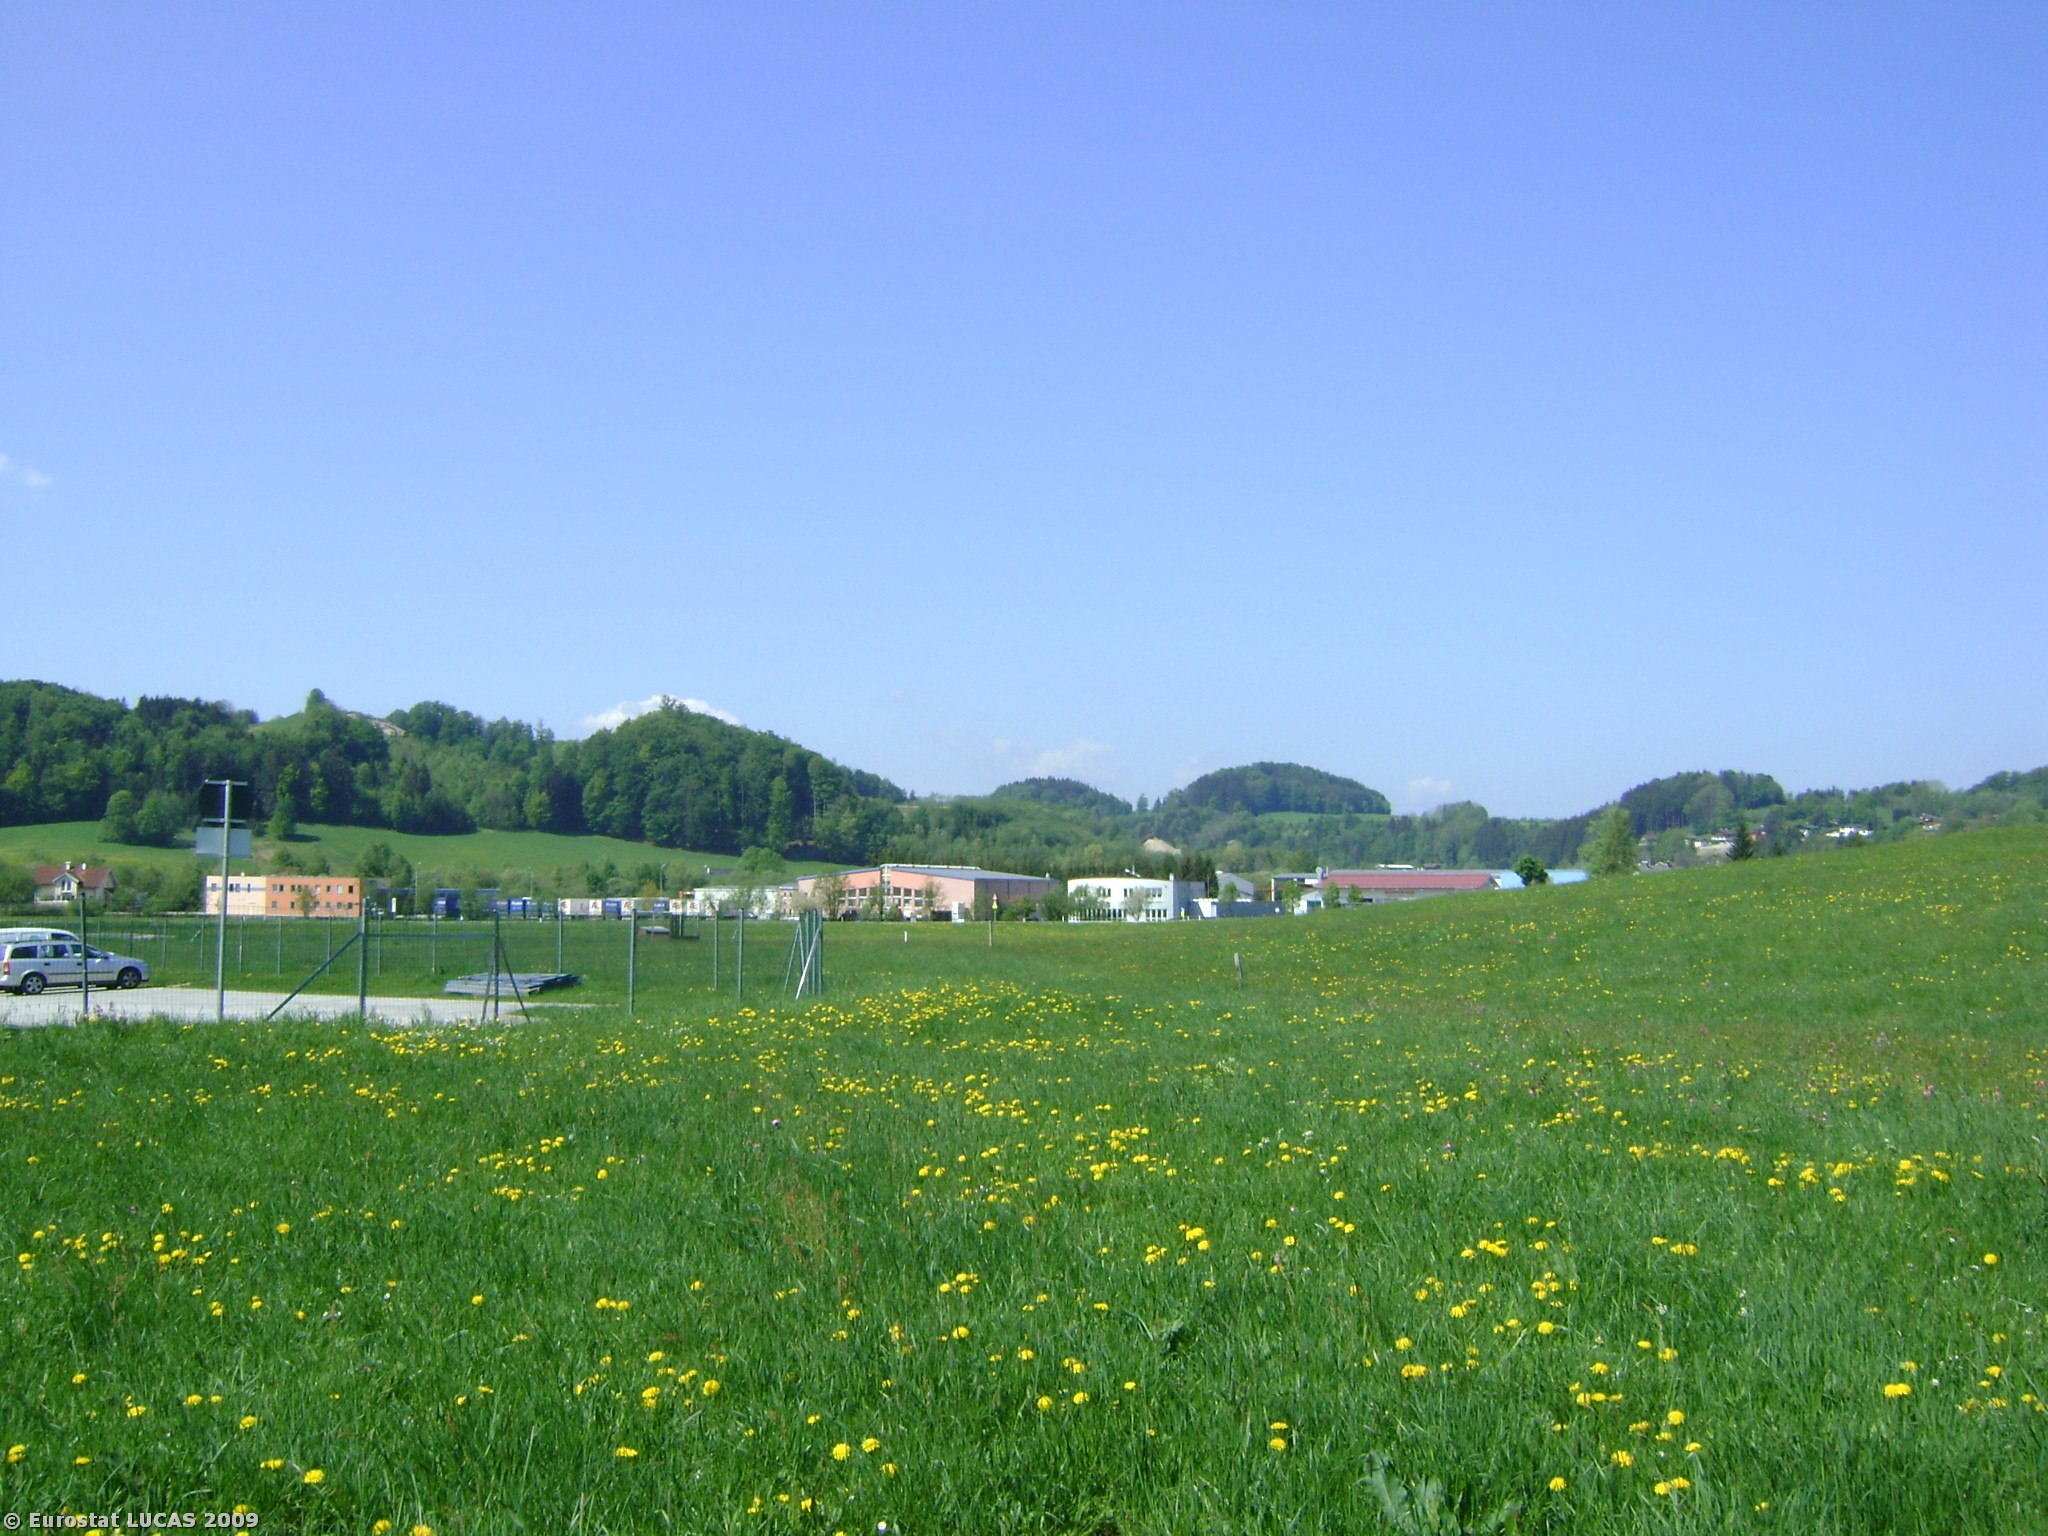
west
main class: Grassland
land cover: Grassland without tree/shrub cover
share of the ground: > 75 %
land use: Agriculture (excluding fallow land and kitchen gardens)
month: May
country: AT
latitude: 47.8524
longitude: 13.2196
